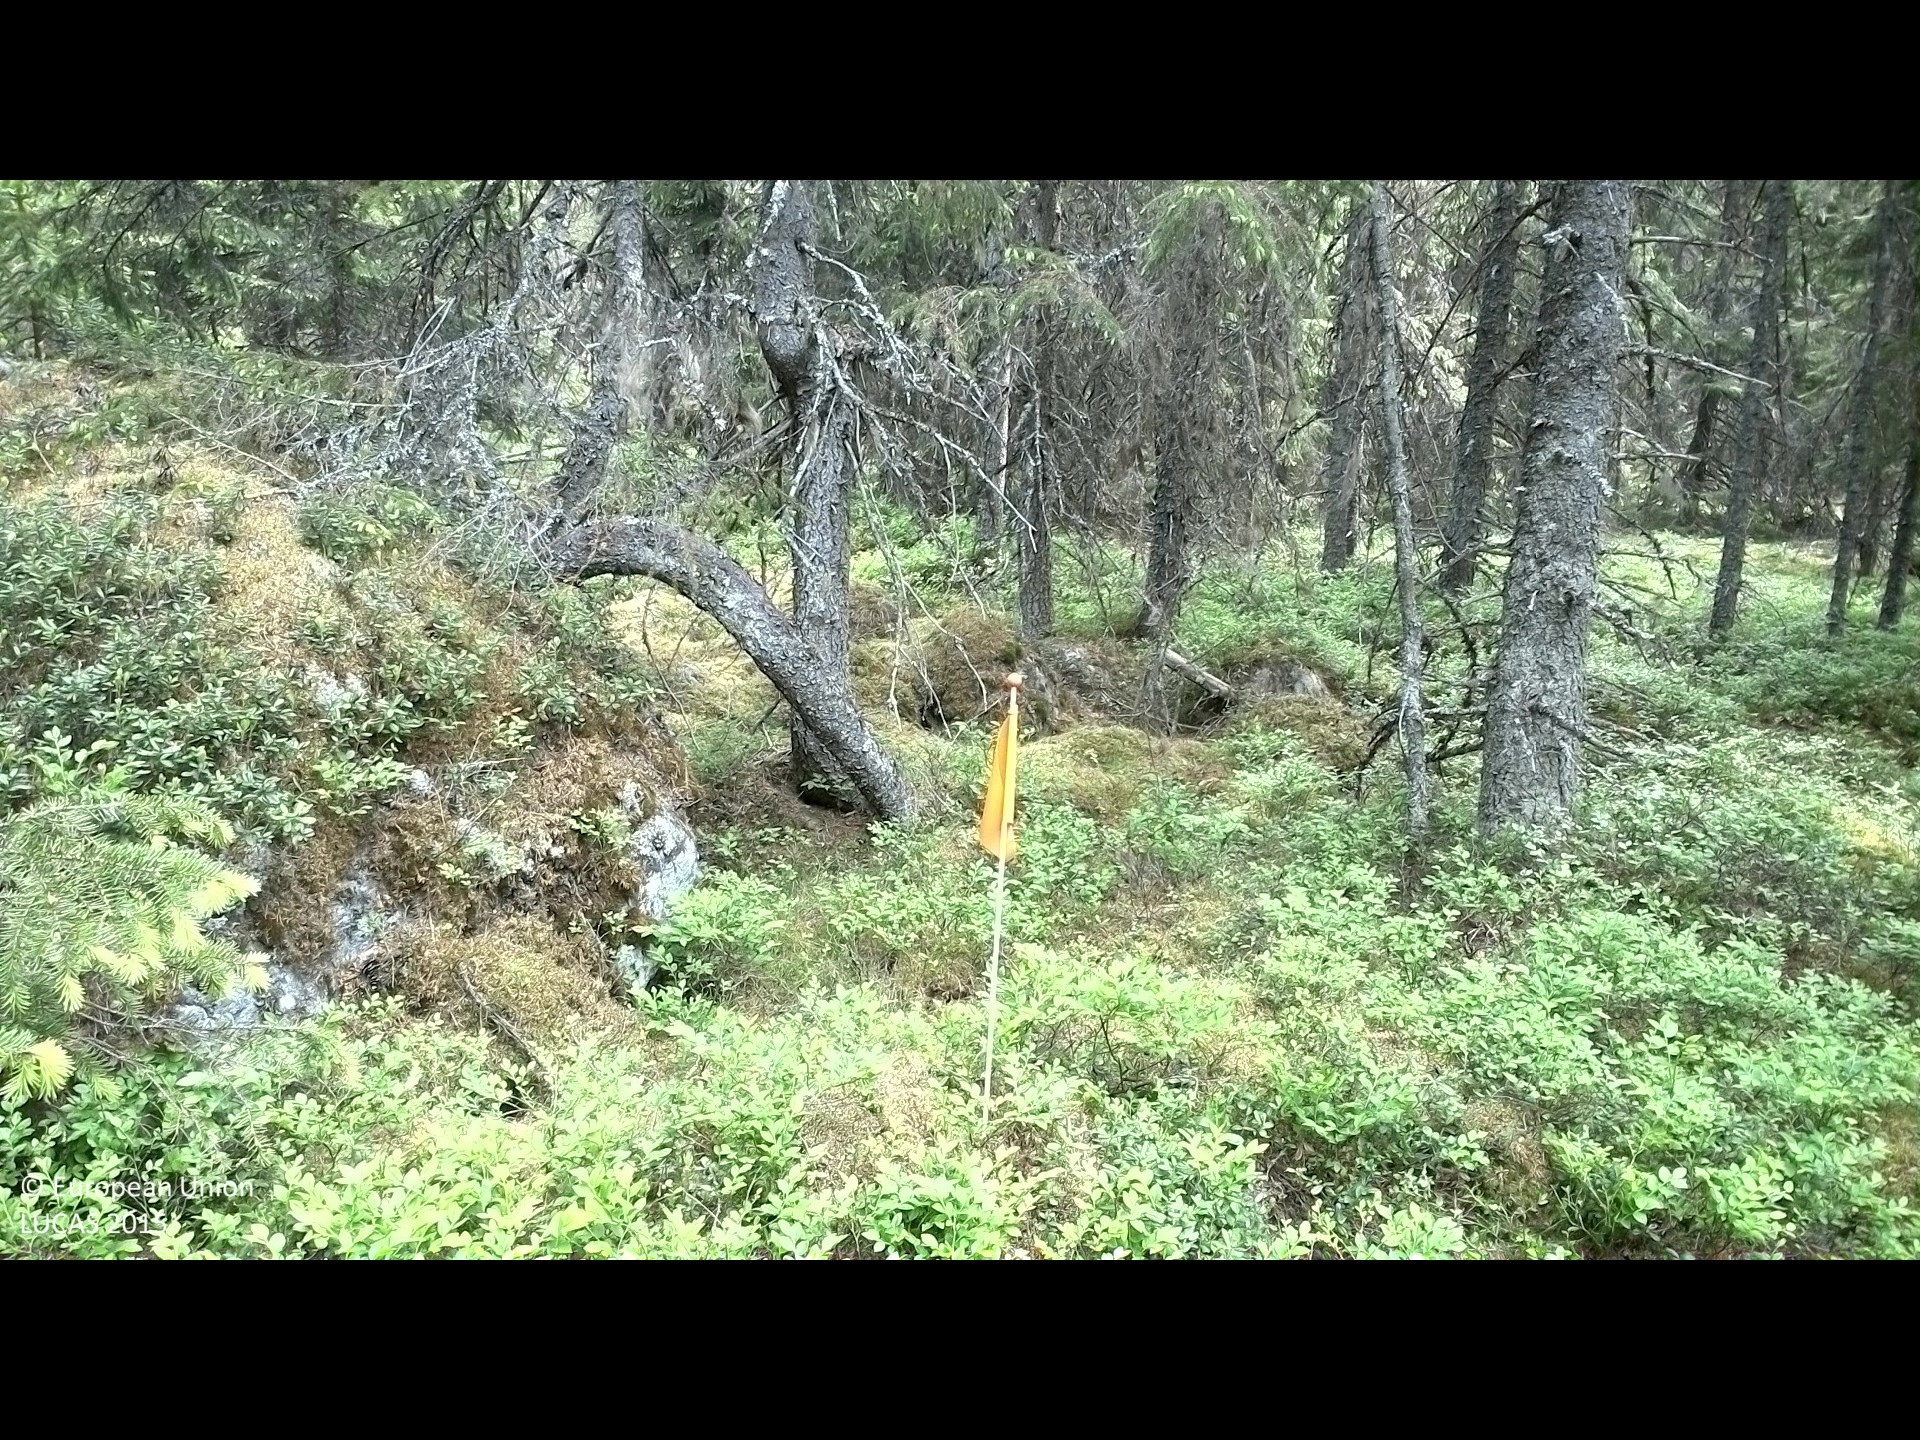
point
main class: Woodland
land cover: Spruce dominated coniferous woodland
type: boreal forest
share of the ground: 50 - 75 %
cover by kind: coniferous forest trees 60 %, lichens and mosses 20 %, shrubs 15 %, herbaceous plants 5 %
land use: Amenities, museums, leisure
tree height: > 5 m
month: June
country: SE
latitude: 62.2201
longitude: 17.6174
